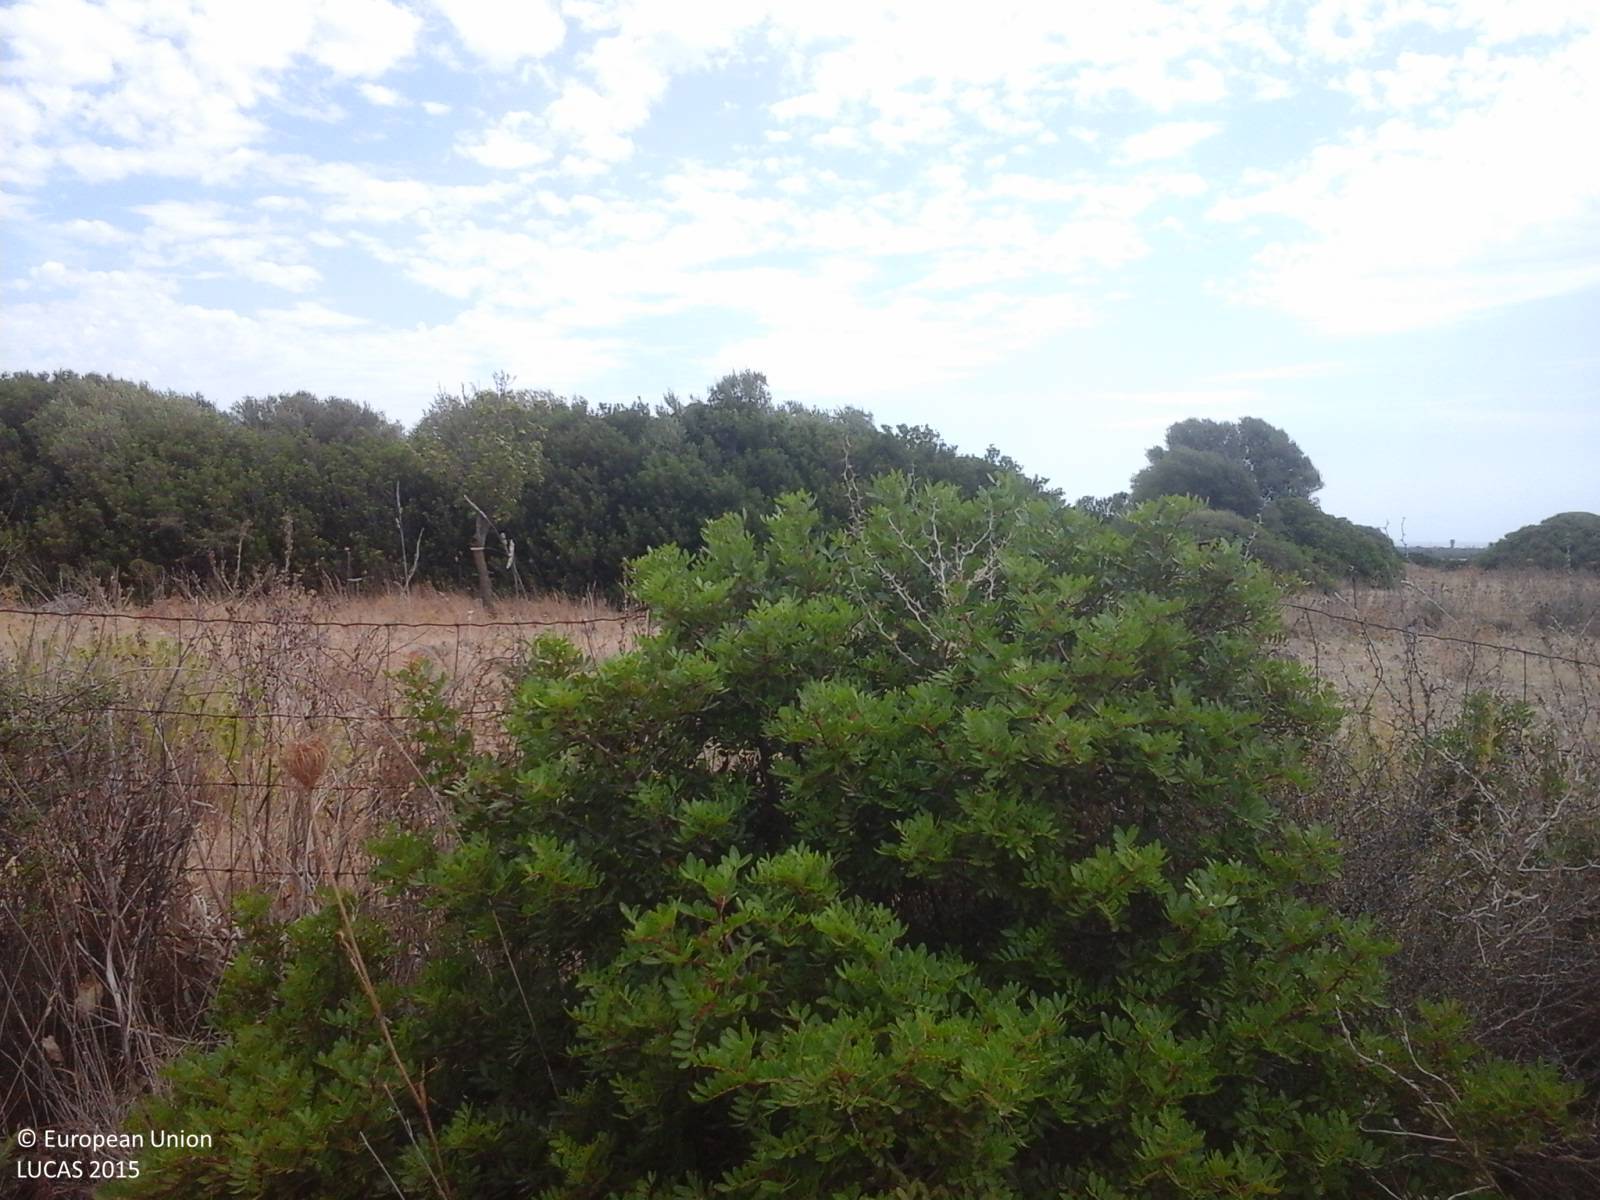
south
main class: Shrubland
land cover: Shrubland without tree cover
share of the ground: > 75 %
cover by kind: shrubs 60 %, herbaceous plants 30 %, unconsolidated bare surface 10 %
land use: Agriculture (excluding fallow land and kitchen gardens)
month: July
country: IT
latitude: 39.1155
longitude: 8.5633
